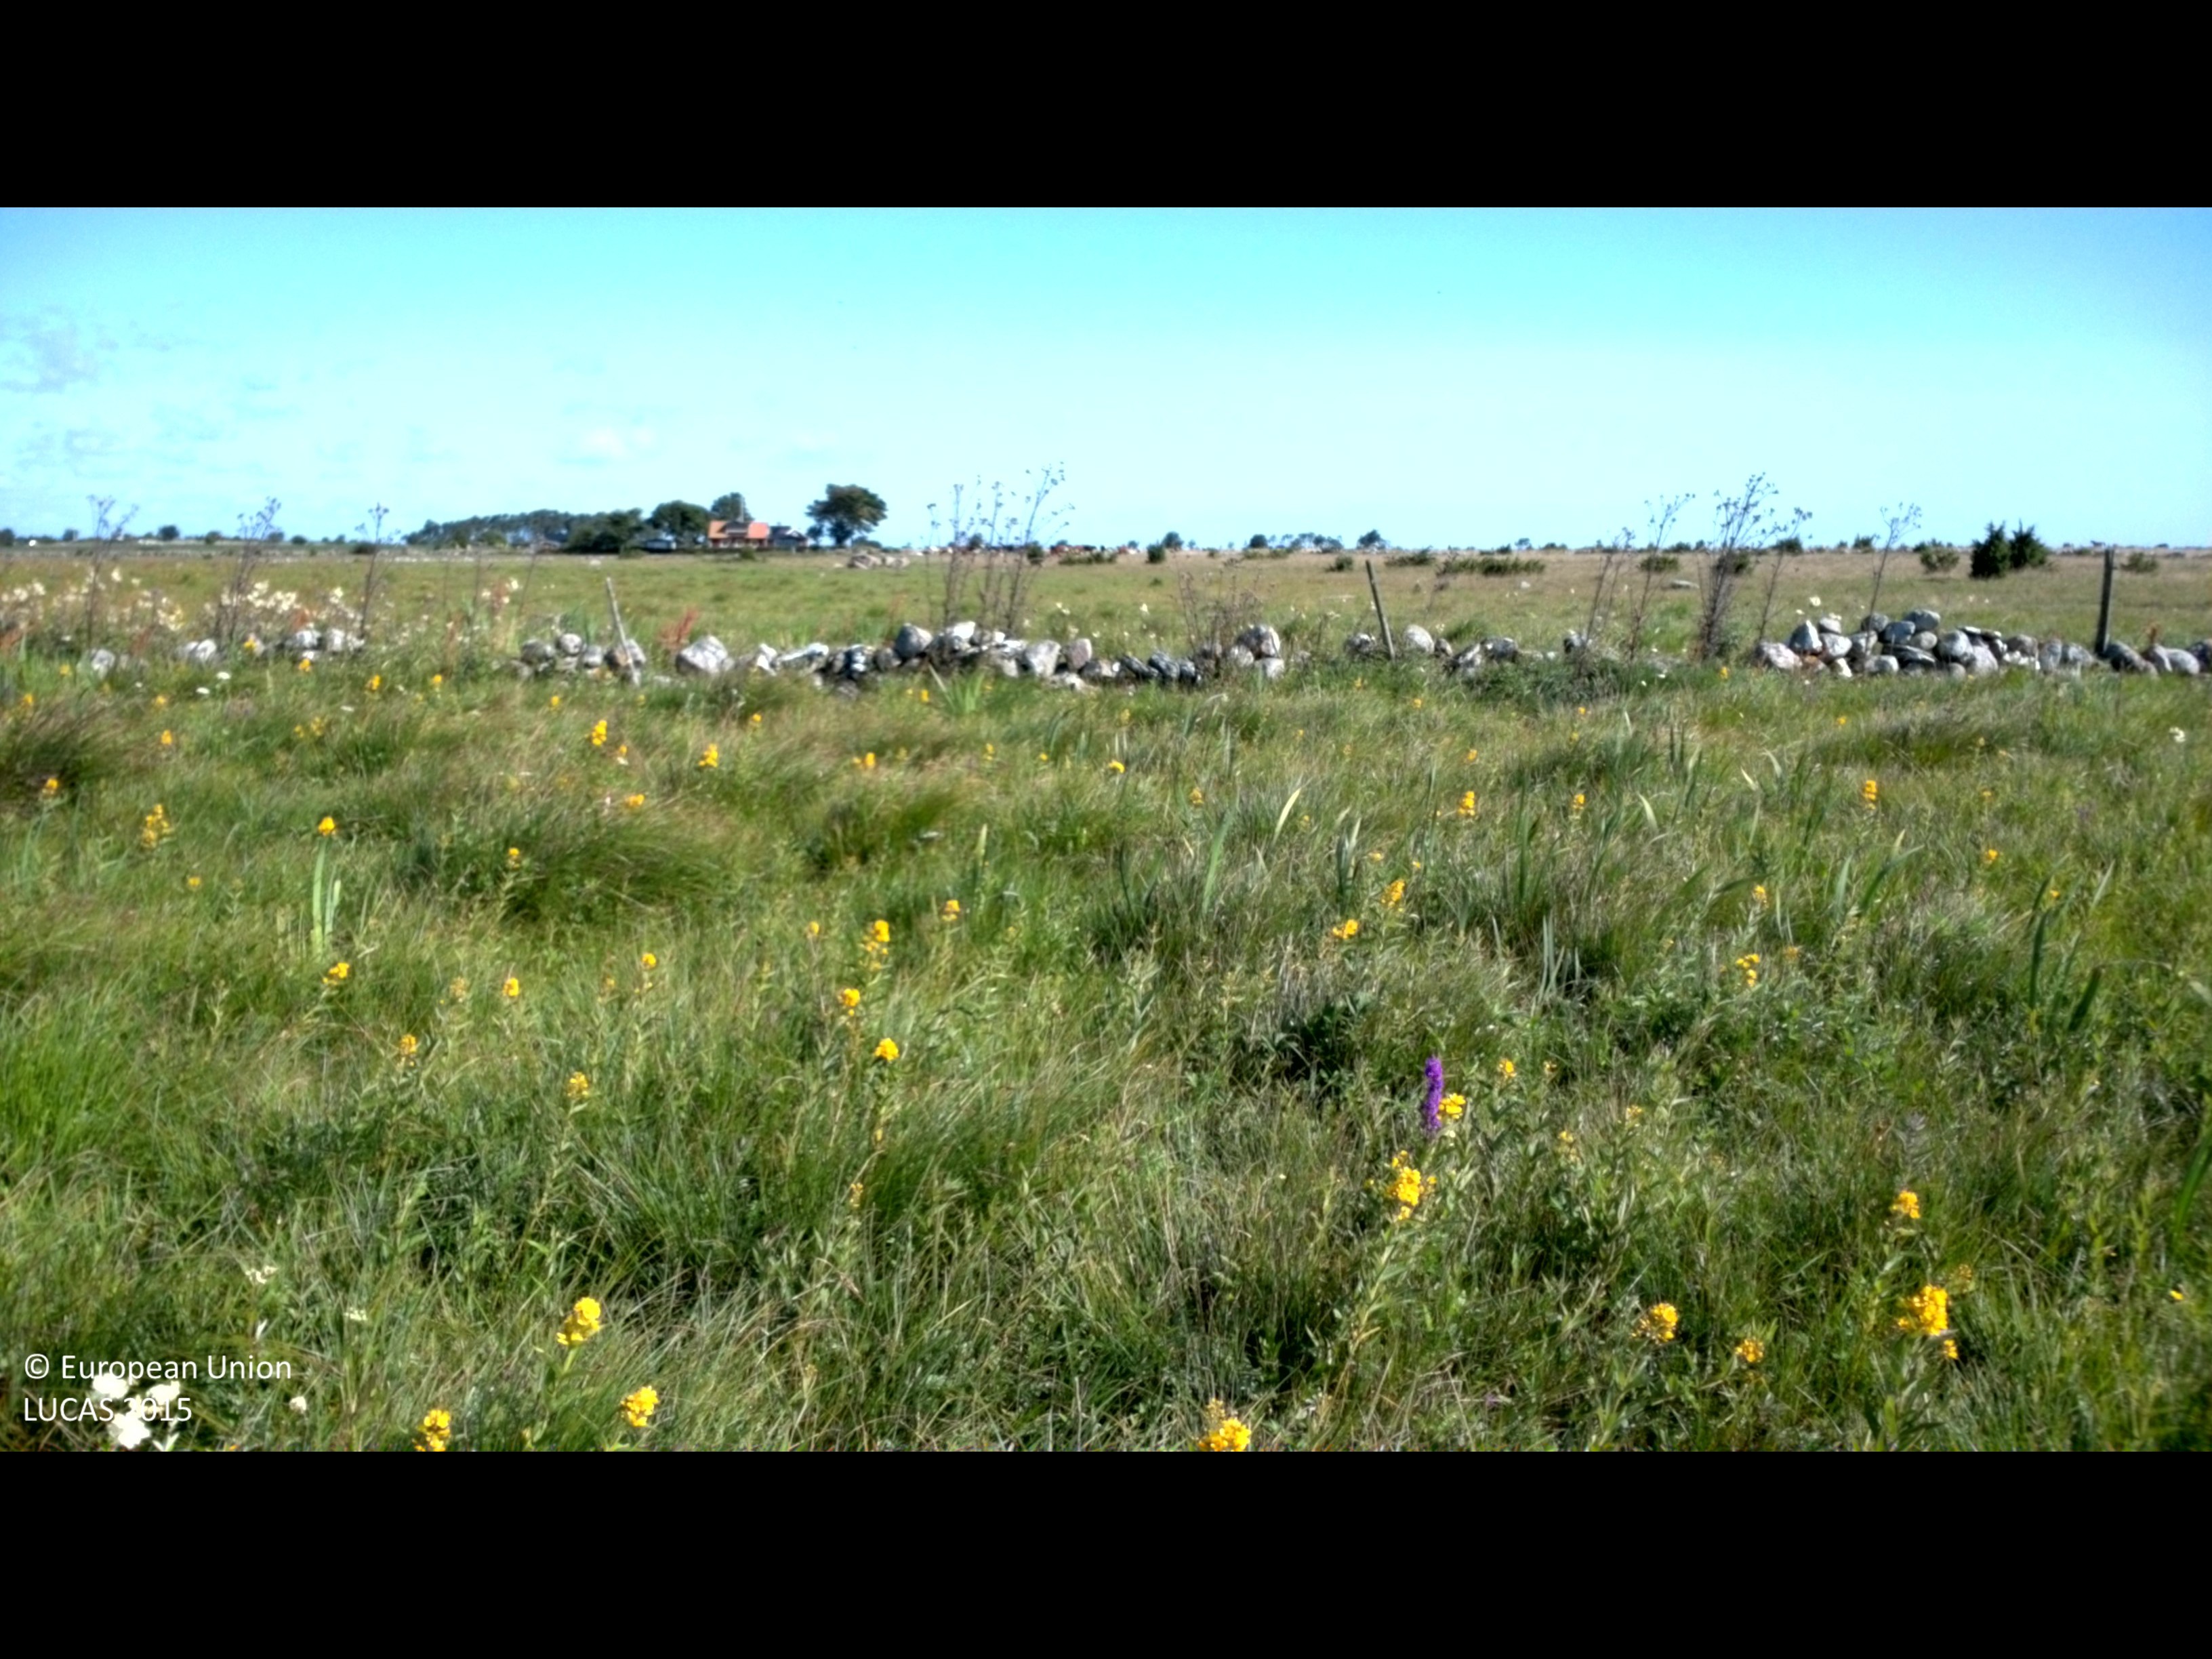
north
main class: Grassland
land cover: Grassland without tree/shrub cover
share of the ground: > 75 %
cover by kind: herbaceous plants 100 %
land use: Agriculture (excluding fallow land and kitchen gardens)
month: July
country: SE
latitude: 56.9235
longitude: 16.8859
